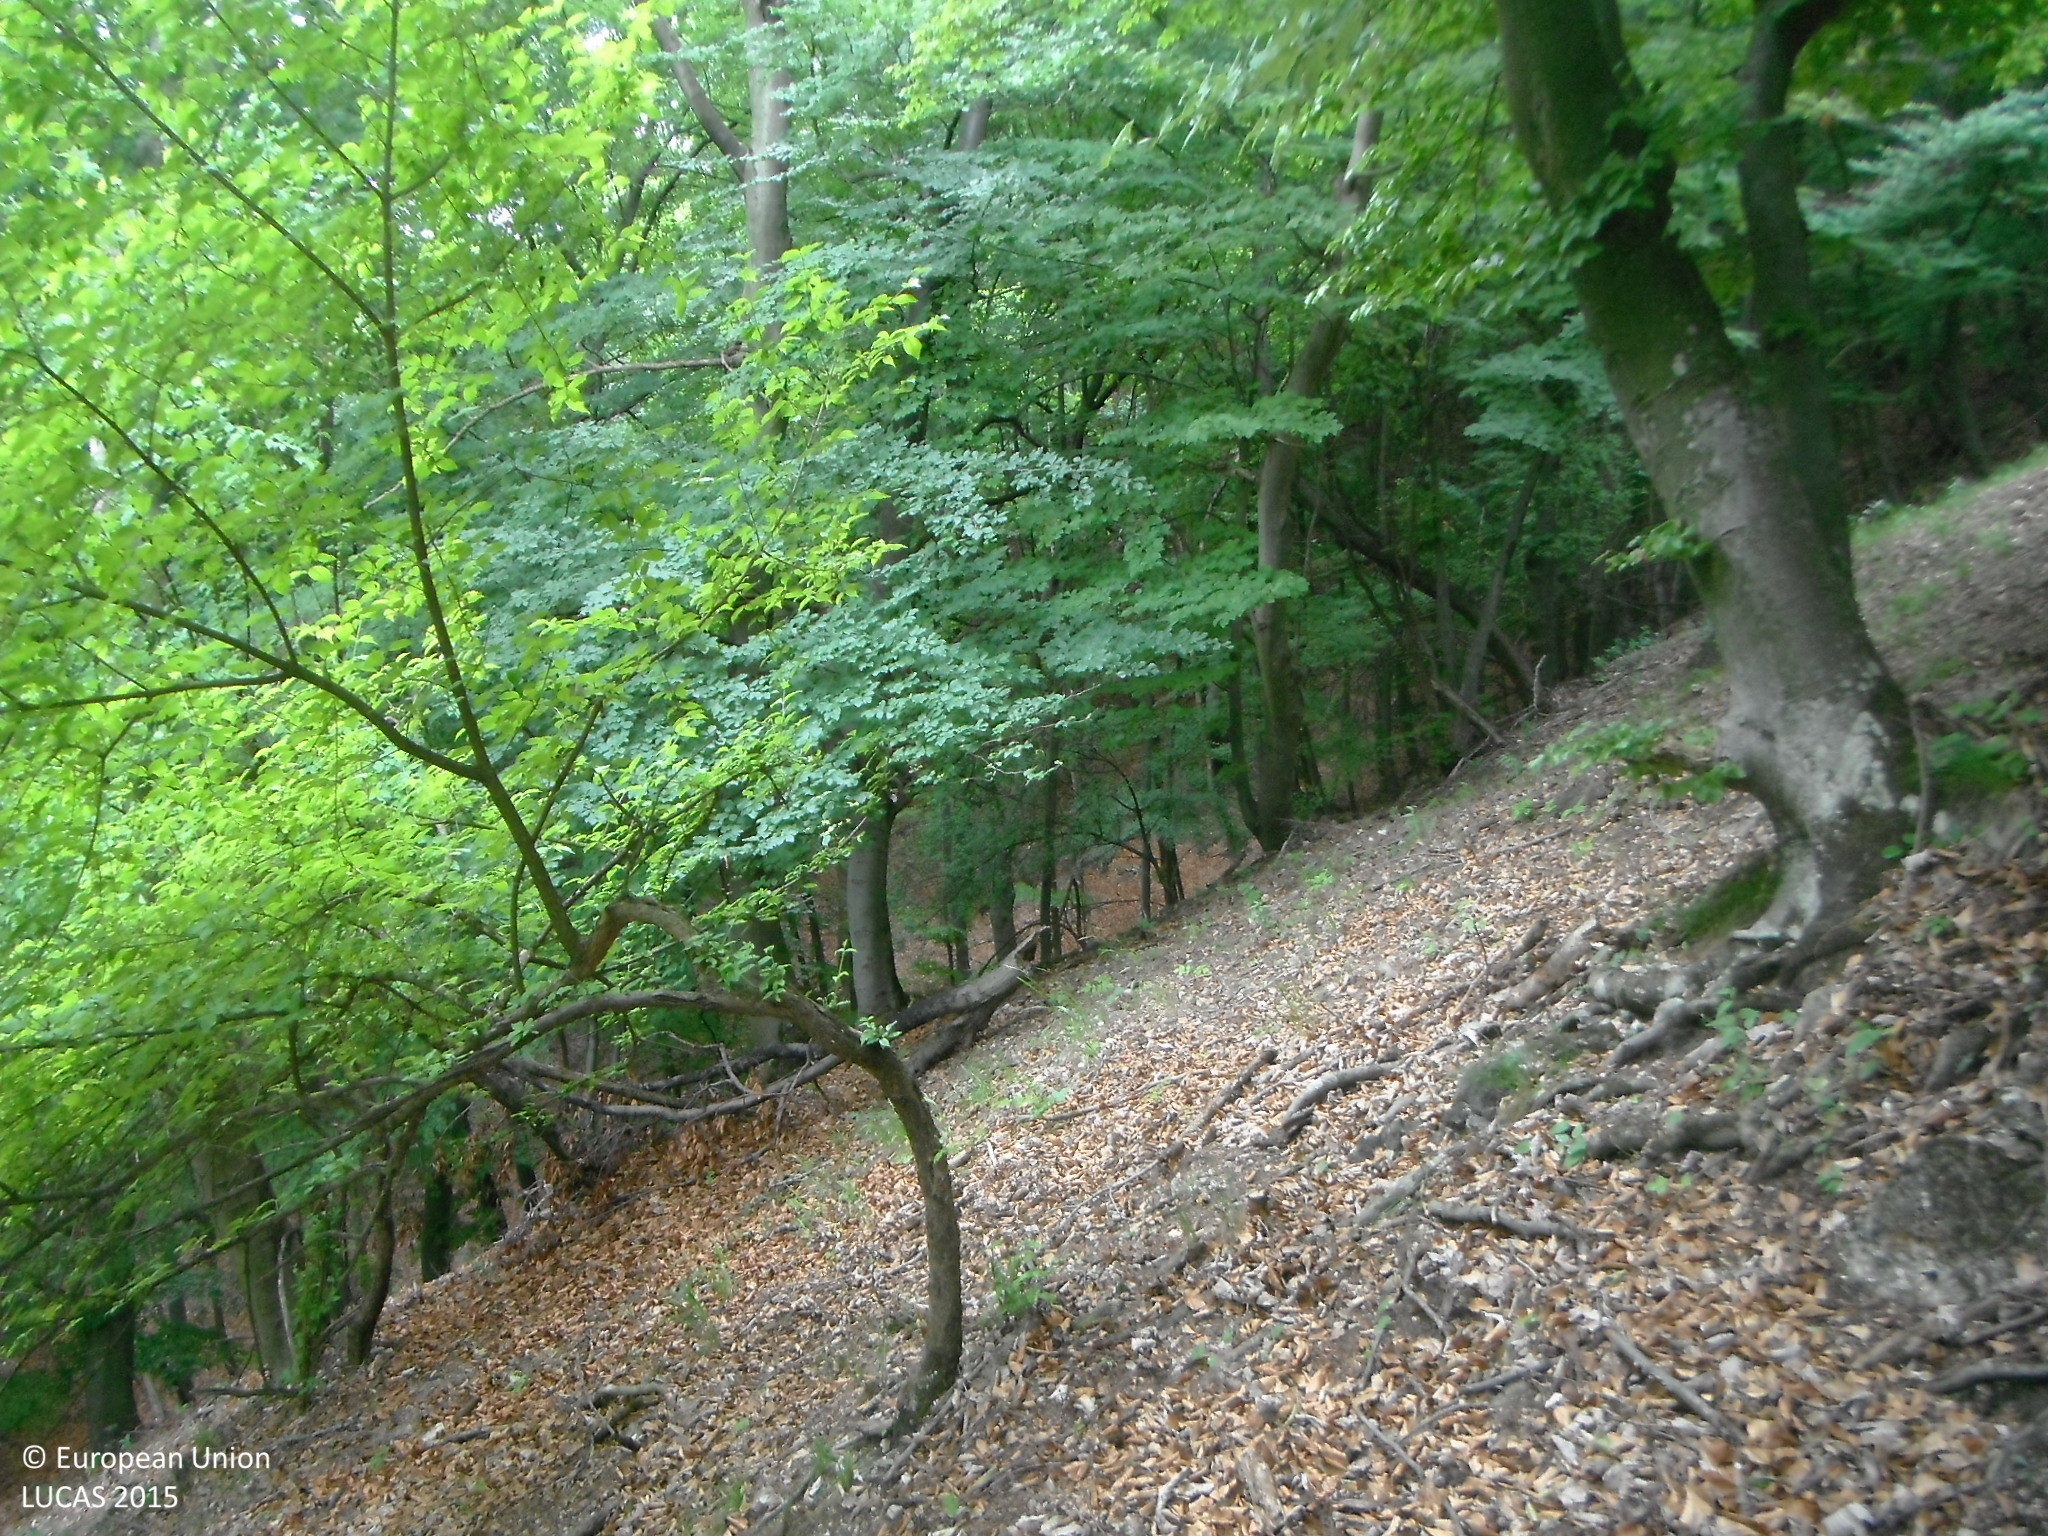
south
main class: Woodland
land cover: Broadleaved woodland
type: beech forest
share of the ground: > 75 %
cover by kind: broadleaved forest trees 80 %, herbaceous plants 15 %, shrubs 5 %
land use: Forestry
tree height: > 5 m
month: June
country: SK
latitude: 48.7541
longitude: 18.3817
